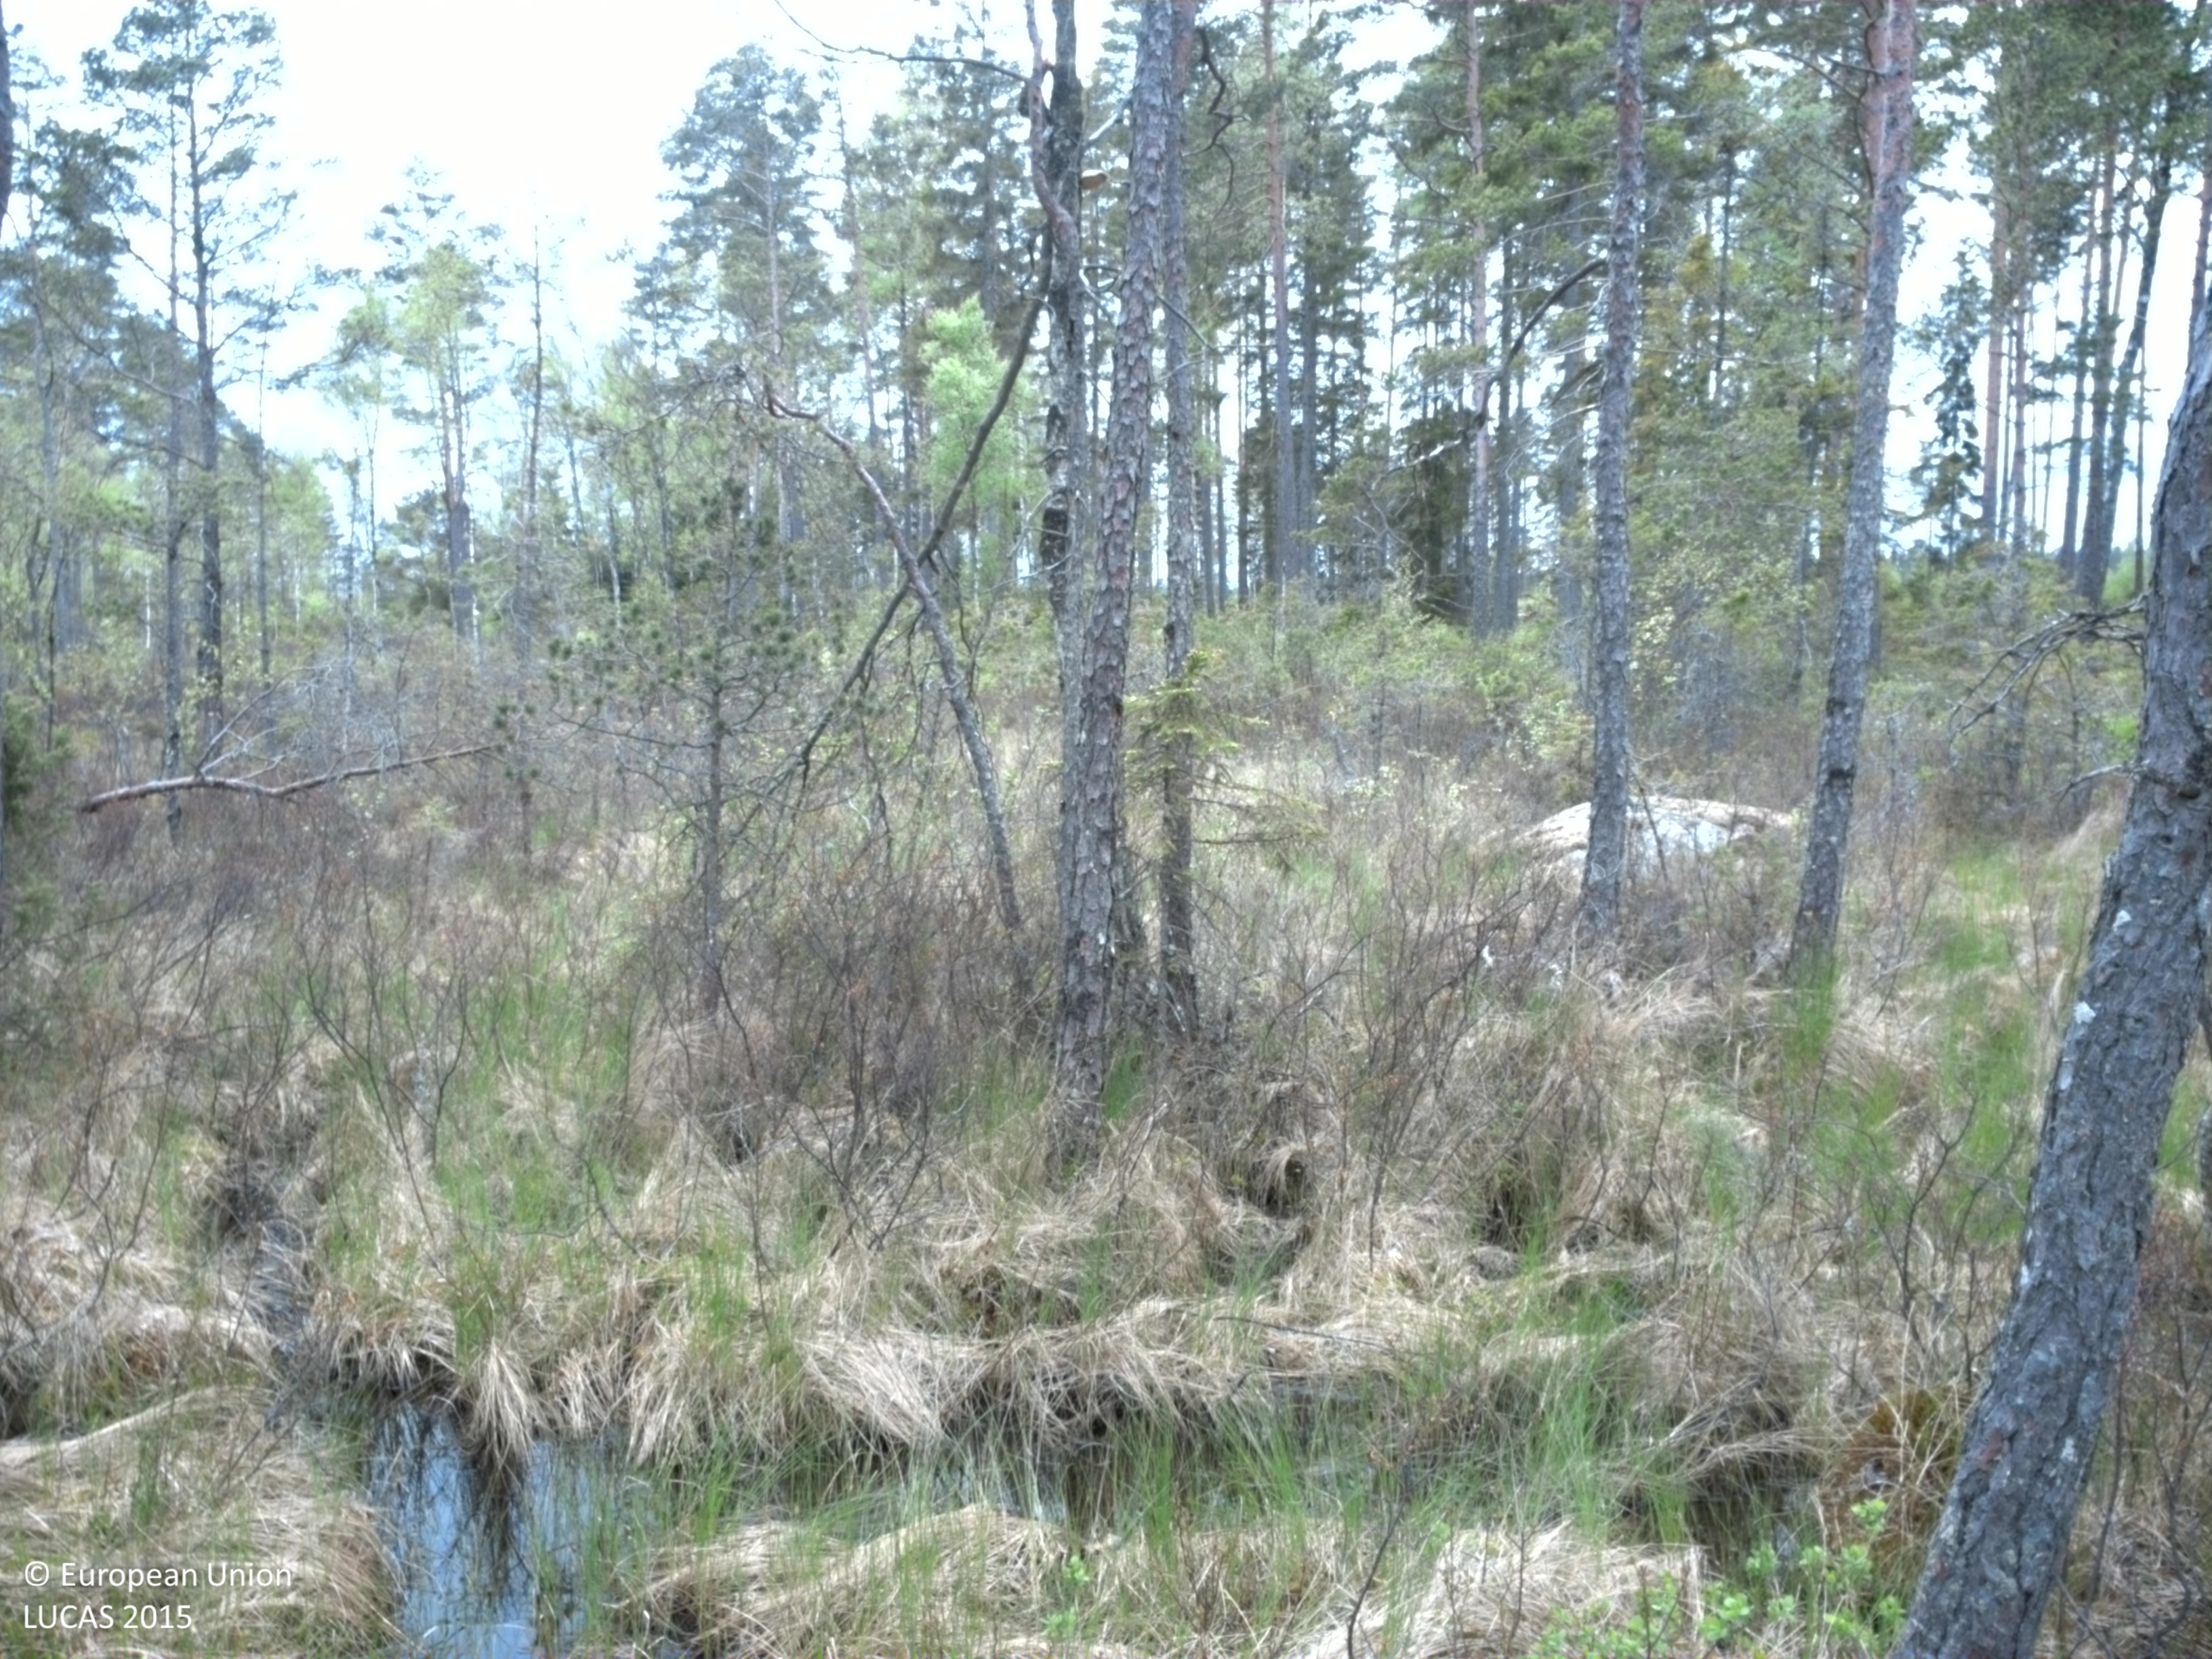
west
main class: Woodland
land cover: Pine dominated coniferous woodland
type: boreal forest
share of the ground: 50 - 75 %
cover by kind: coniferous forest trees 55 %, lichens and mosses 30 %, broadleaved forest trees 15 %
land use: Forestry
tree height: > 5 m
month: May
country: SE
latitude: 56.9330
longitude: 15.1081
